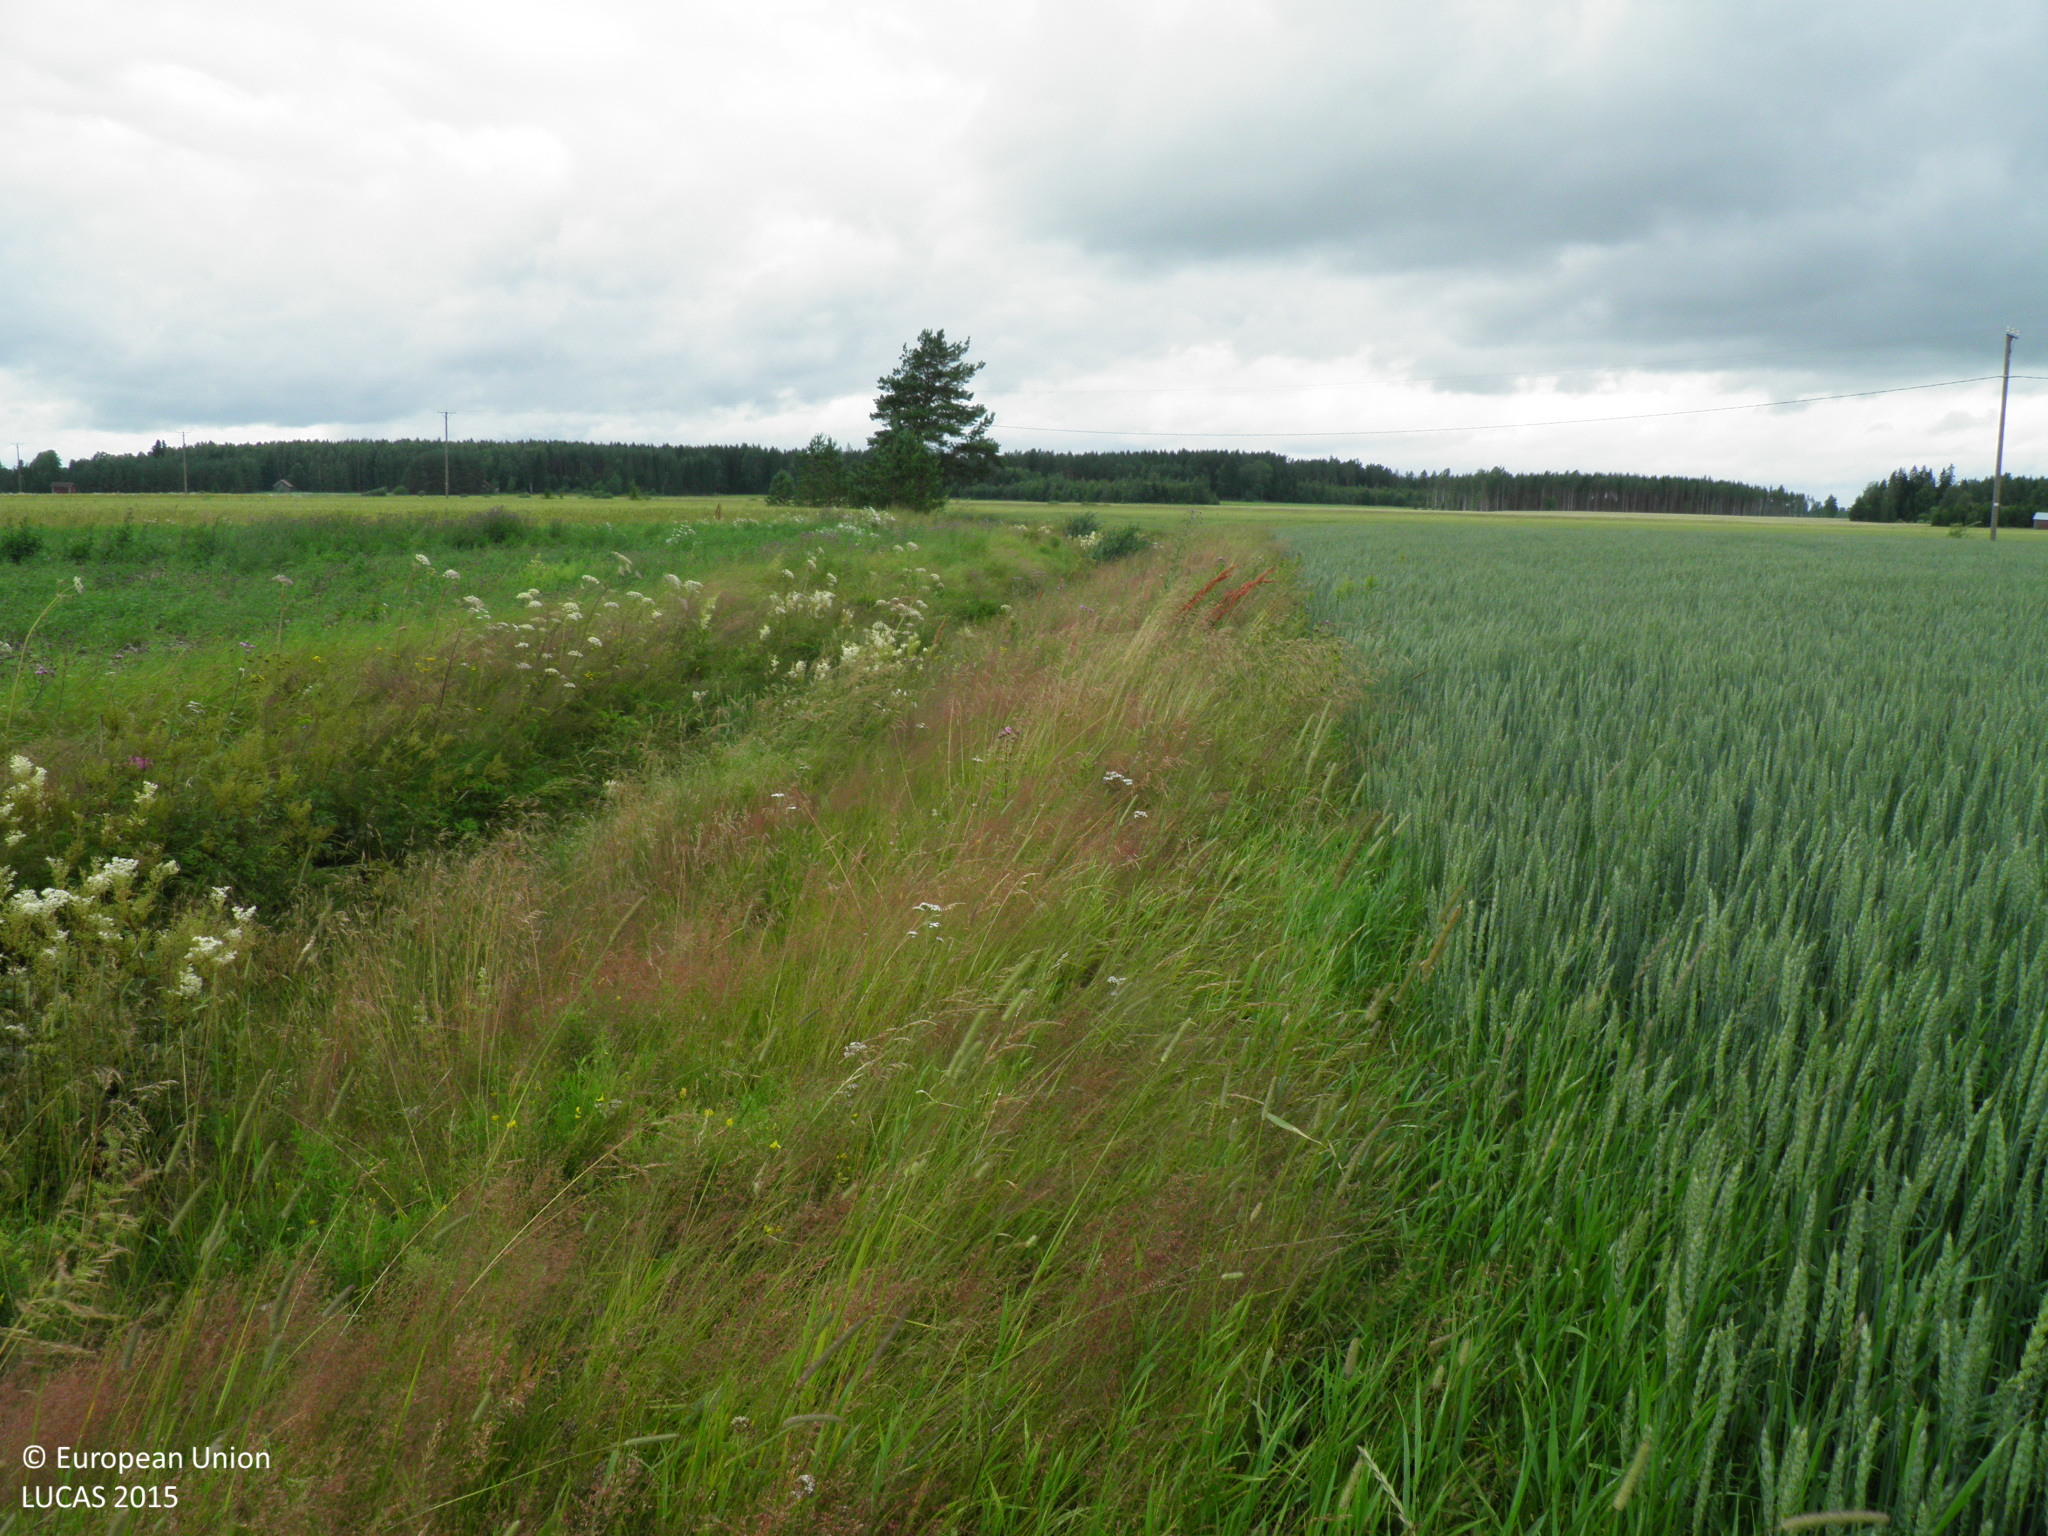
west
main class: Cropland
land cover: Common wheat
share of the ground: > 75 %
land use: Agriculture (excluding fallow land and kitchen gardens)
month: July
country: FI
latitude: 60.9028
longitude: 22.8855
